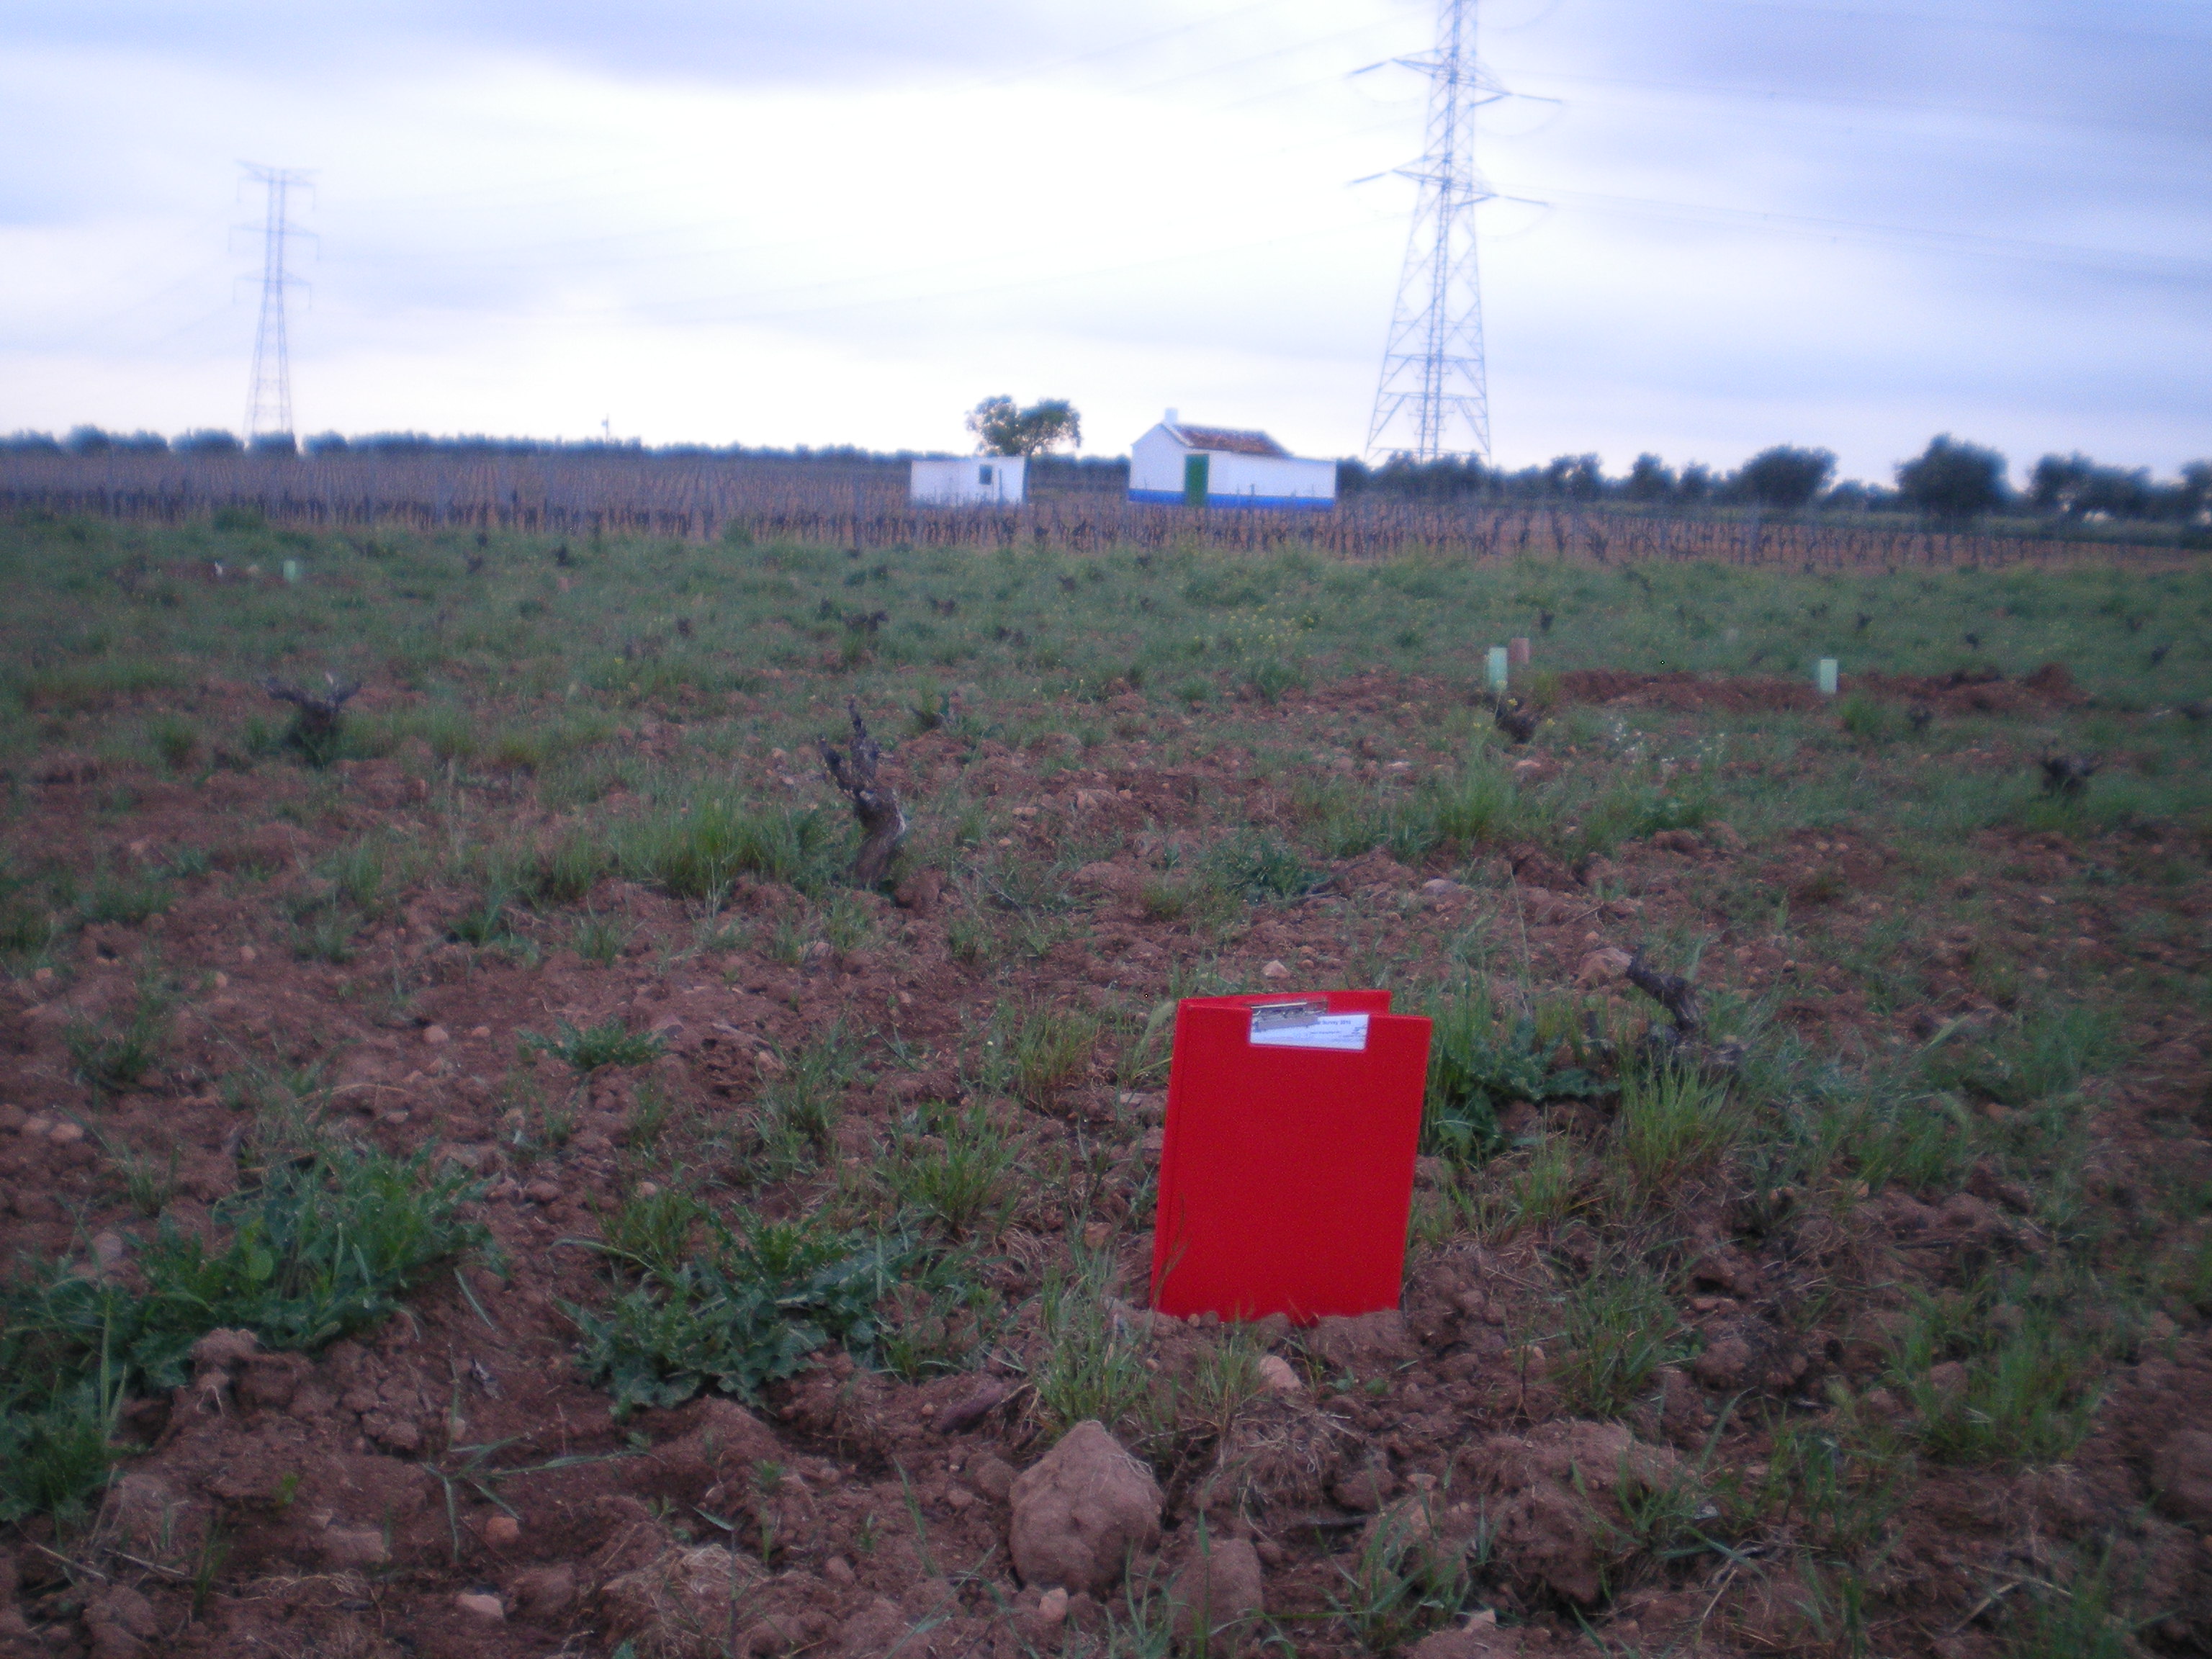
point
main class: Cropland
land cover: Vineyards
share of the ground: < 10 %
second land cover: Spontaneously vegetated surfaces
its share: 25 - 50 %
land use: Agriculture (excluding fallow land and kitchen gardens)
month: April
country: ES
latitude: 38.7809
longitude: -3.4921
